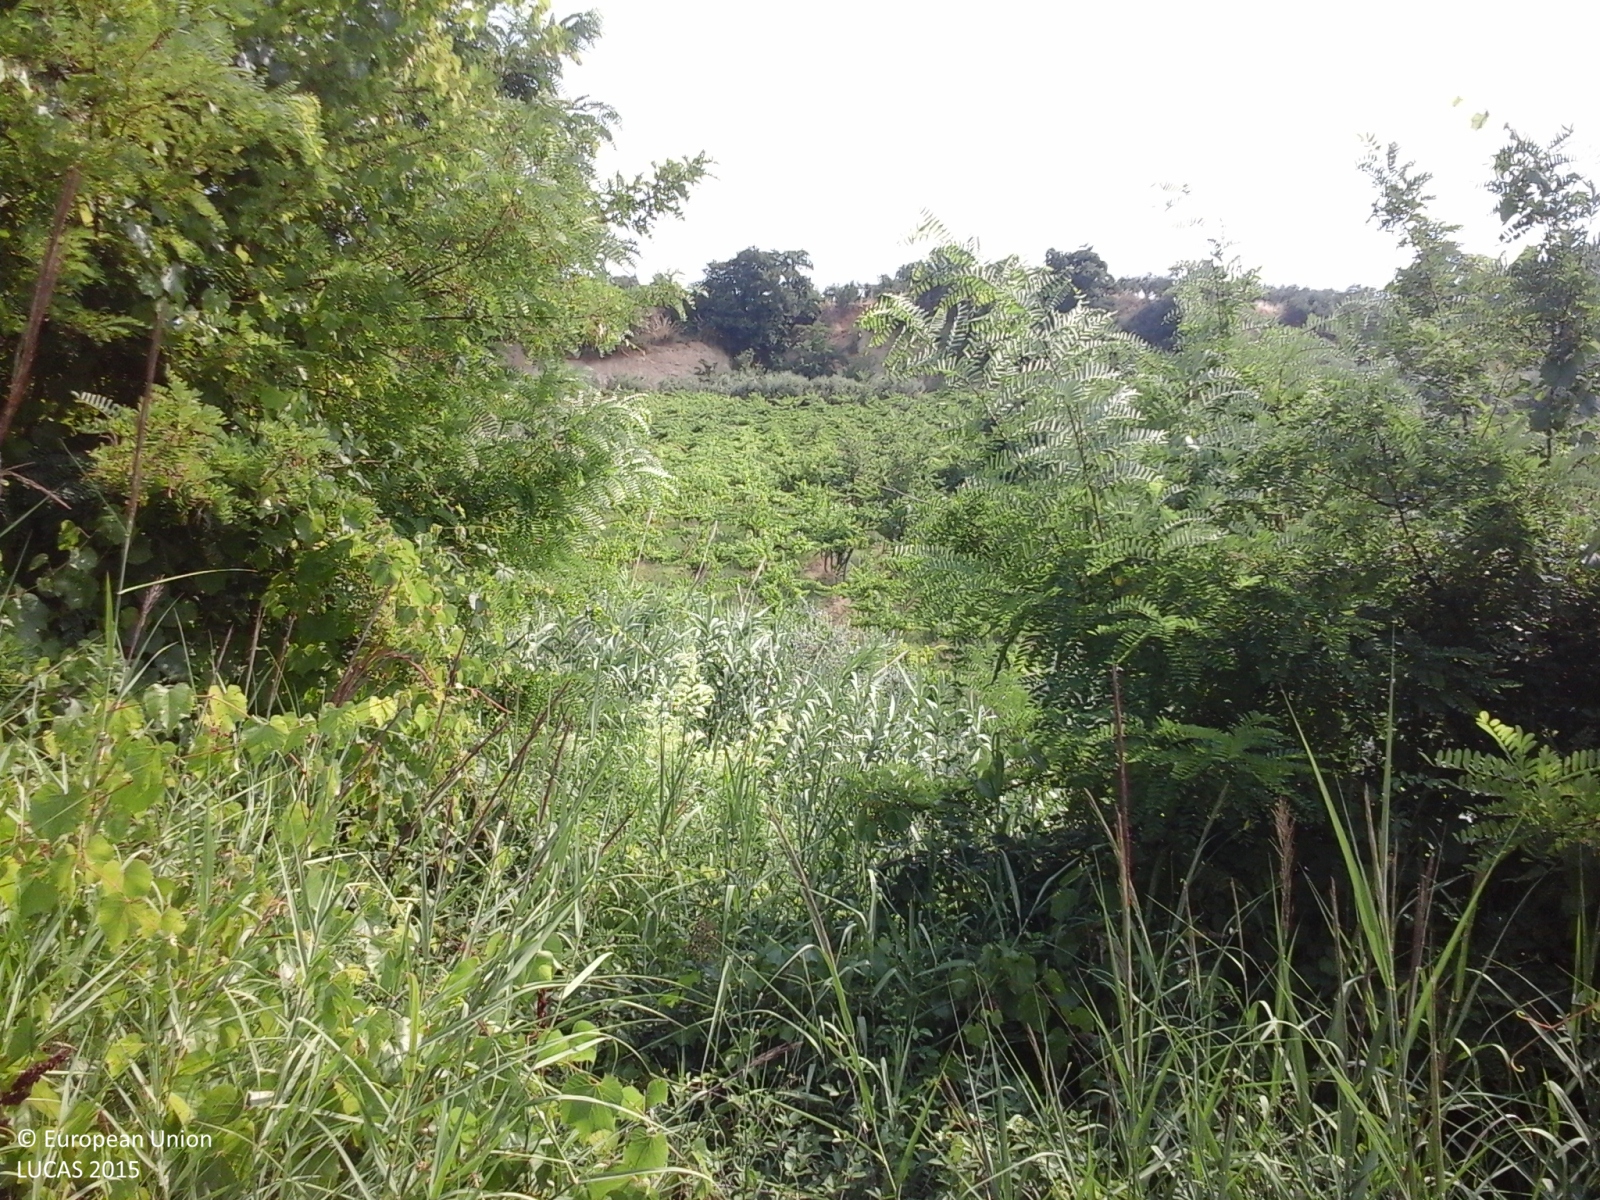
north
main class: Shrubland
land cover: Shrubland with sparse tree cover
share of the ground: 50 - 75 %
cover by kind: shrubs 90 %, broadleaved forest trees 5 %, herbaceous plants 5 %
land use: Abandoned areas
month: July
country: IT
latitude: 42.3479
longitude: 14.2480
